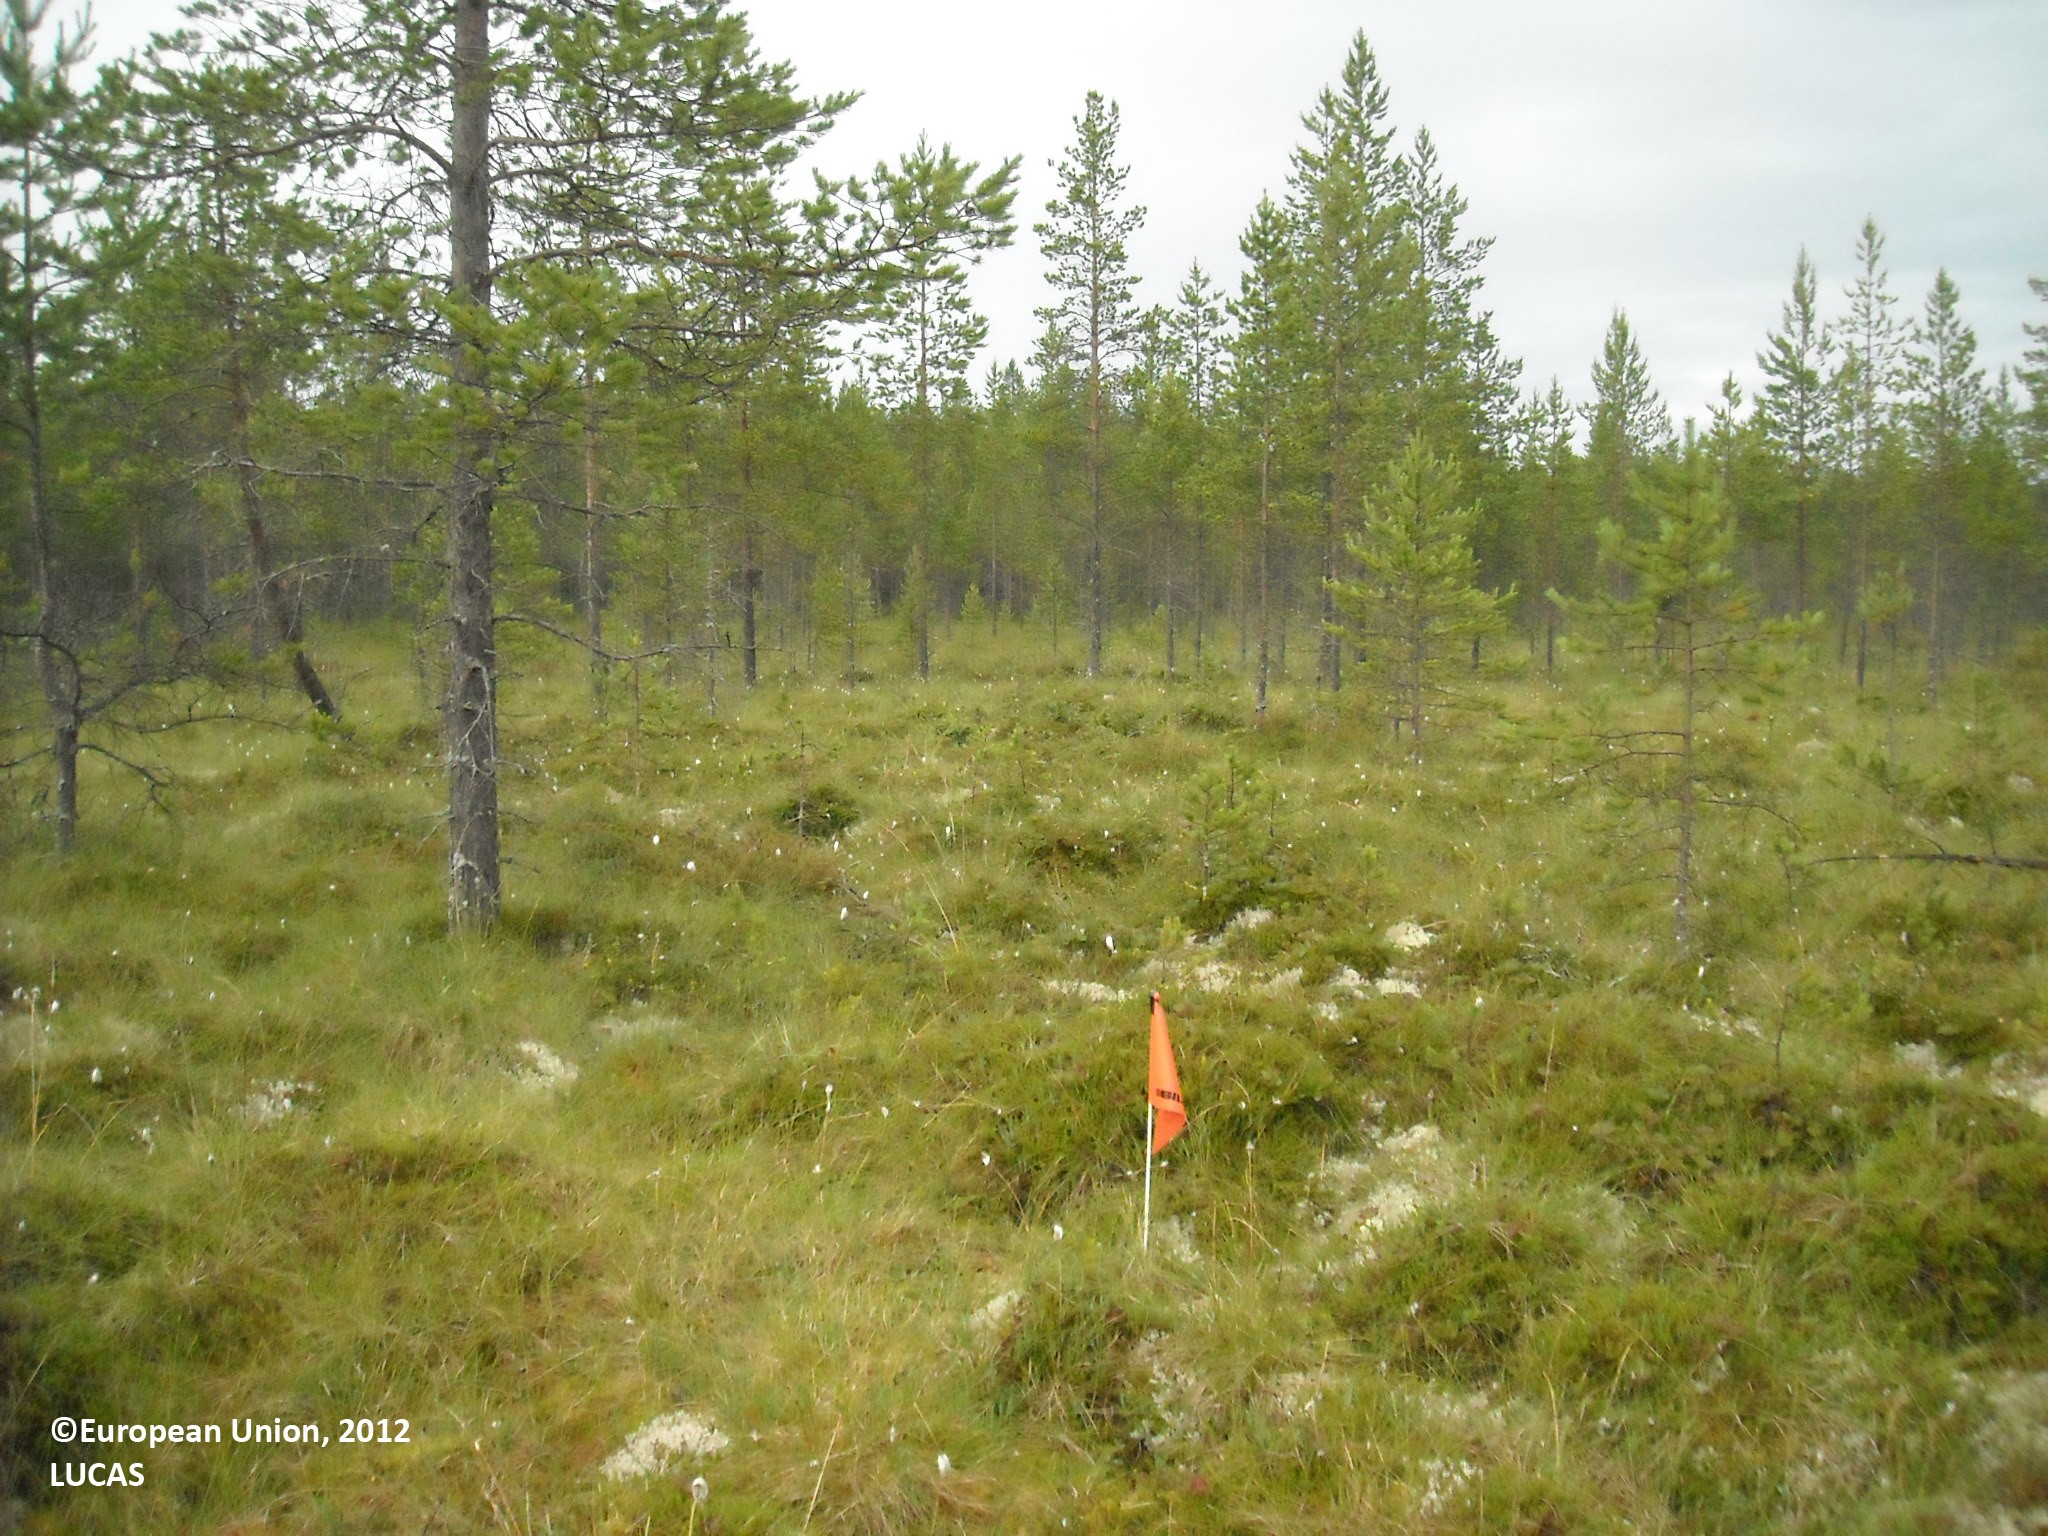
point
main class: Woodland
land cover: Pine dominated coniferous woodland
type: mire and swamp forests
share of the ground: 25 - 50 %
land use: Semi-natural and natural areas not in use
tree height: > 5 m
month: July
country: FI
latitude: 64.7958
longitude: 26.7654
